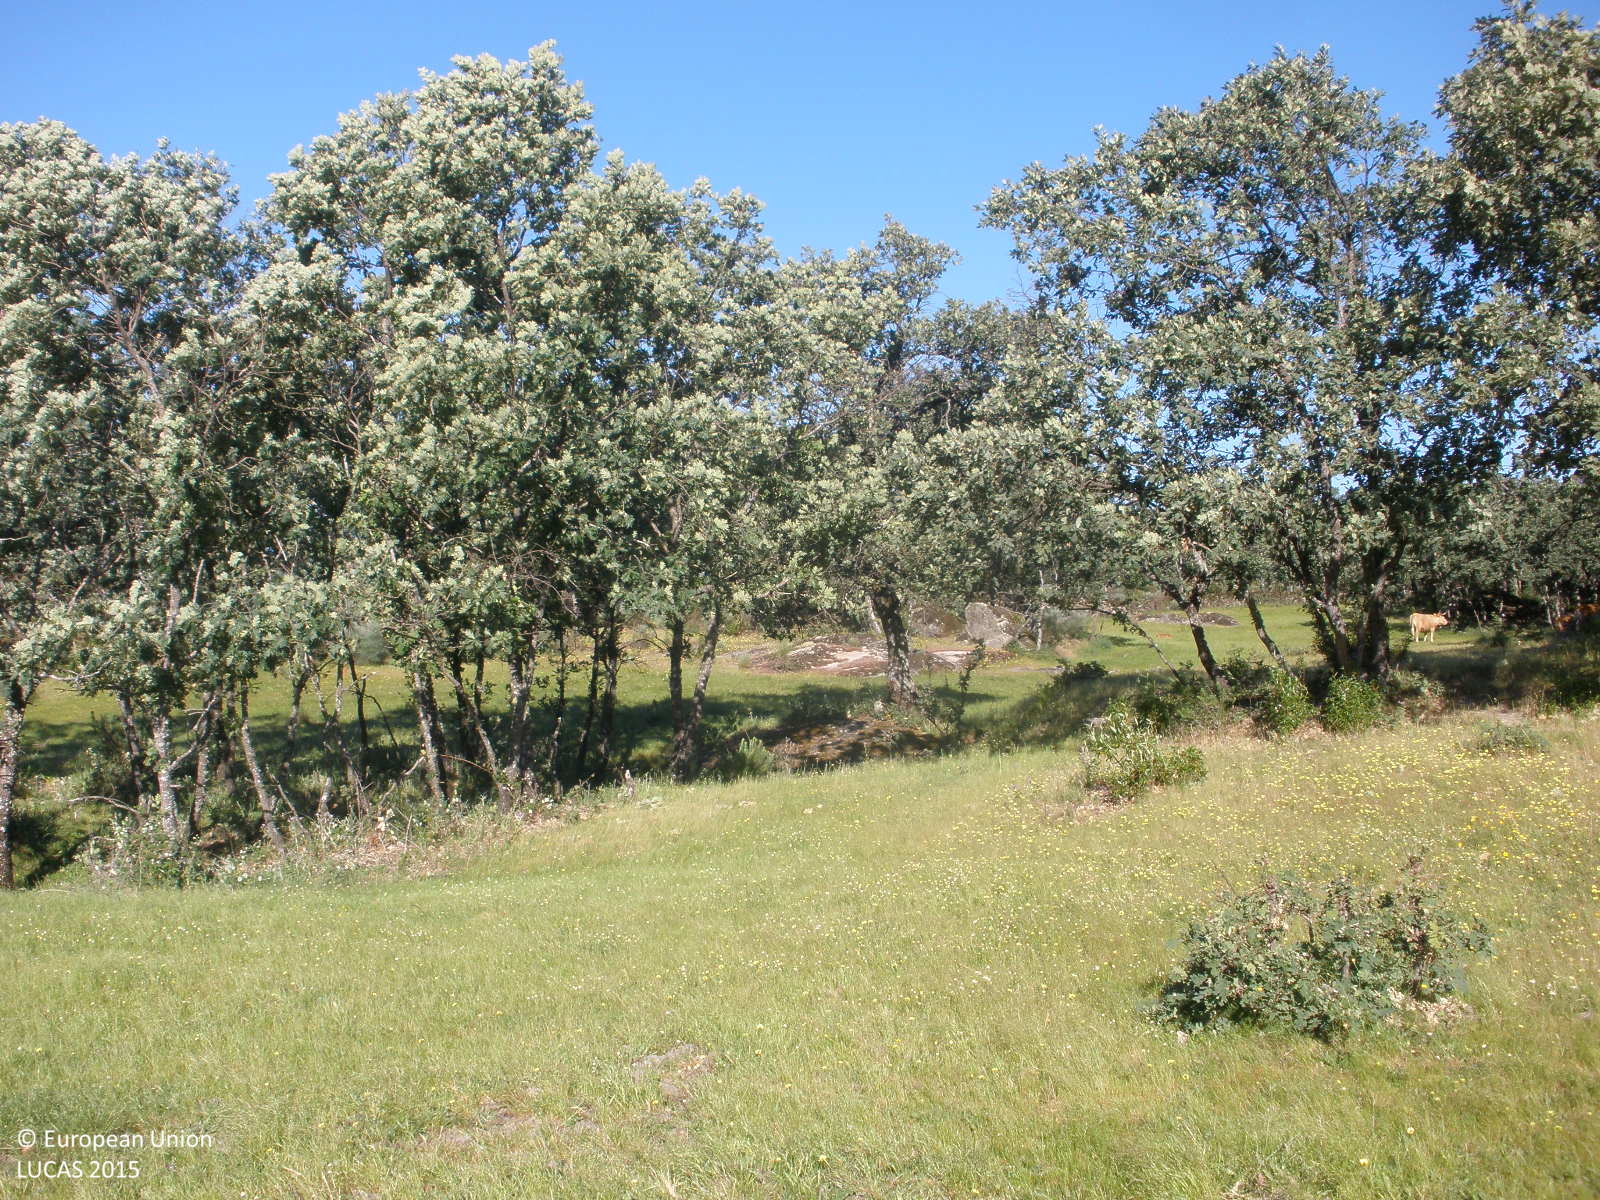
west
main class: Grassland
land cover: Grassland without tree/shrub cover
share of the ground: > 75 %
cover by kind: herbaceous plants 95 %, shrubs 5 %
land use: Agriculture (excluding fallow land and kitchen gardens)
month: May
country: ES
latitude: 40.1630
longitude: -6.8444
